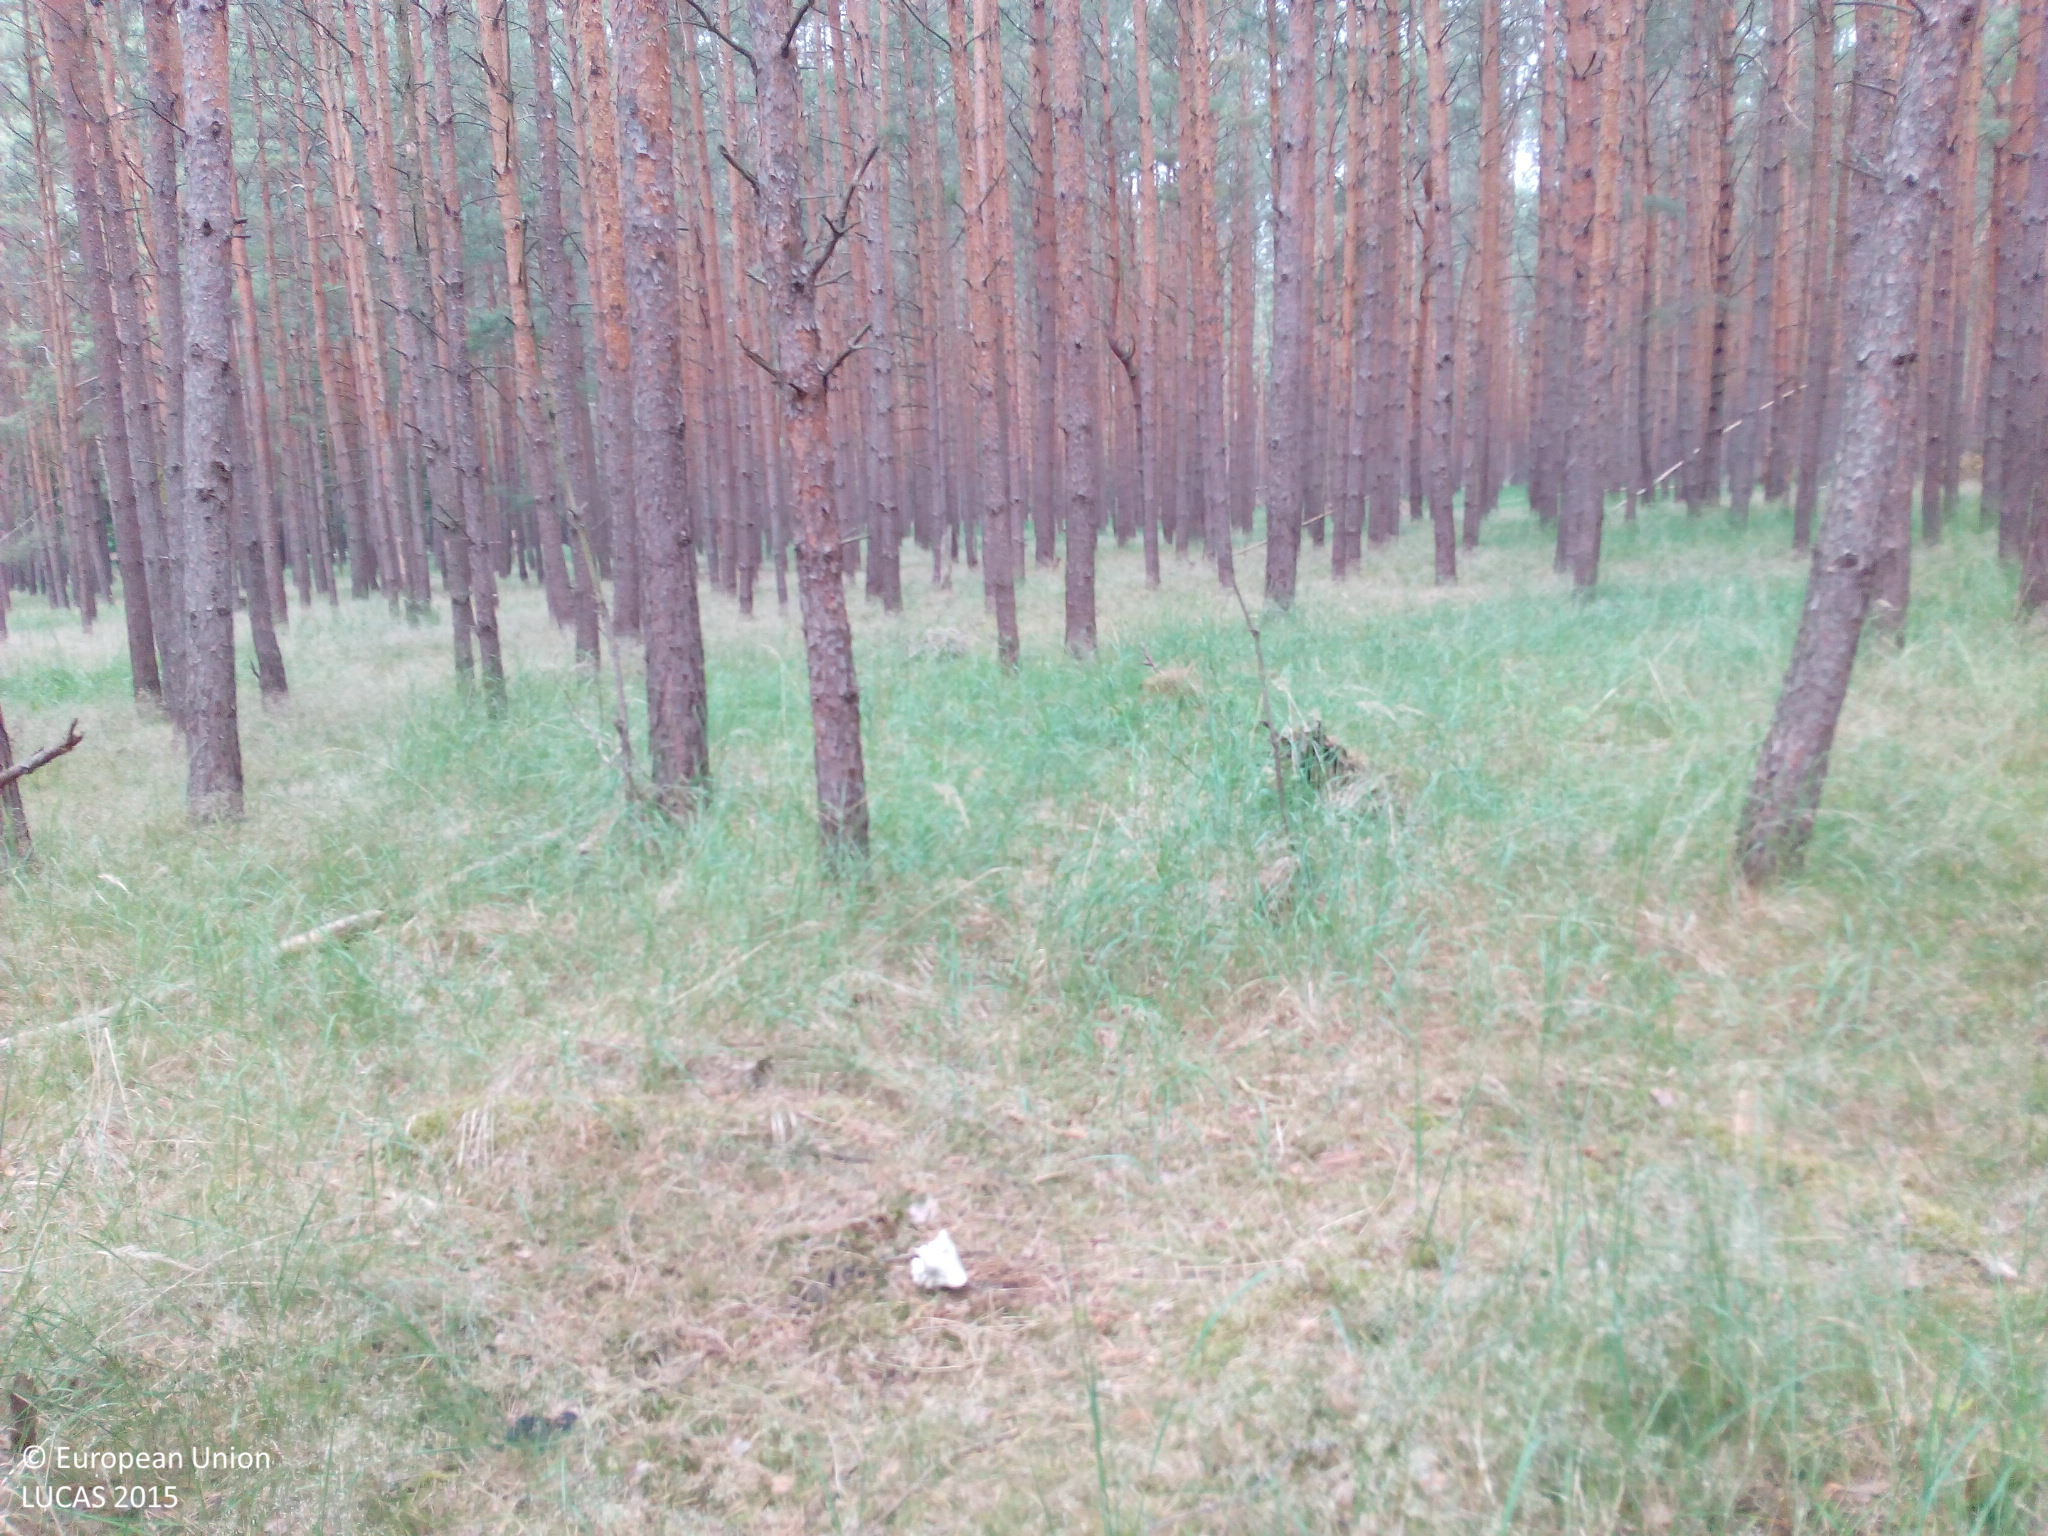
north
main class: Woodland
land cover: Pine dominated coniferous woodland
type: hemiboreal forest and nemoral coniferous forest and mixed broadleaved-coniferous forest
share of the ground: > 75 %
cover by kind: coniferous forest trees 90 %, herbaceous plants 10 %
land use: Forestry
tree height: > 5 m
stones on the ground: < 10 %
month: June
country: DE
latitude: 52.1905
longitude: 12.4425
